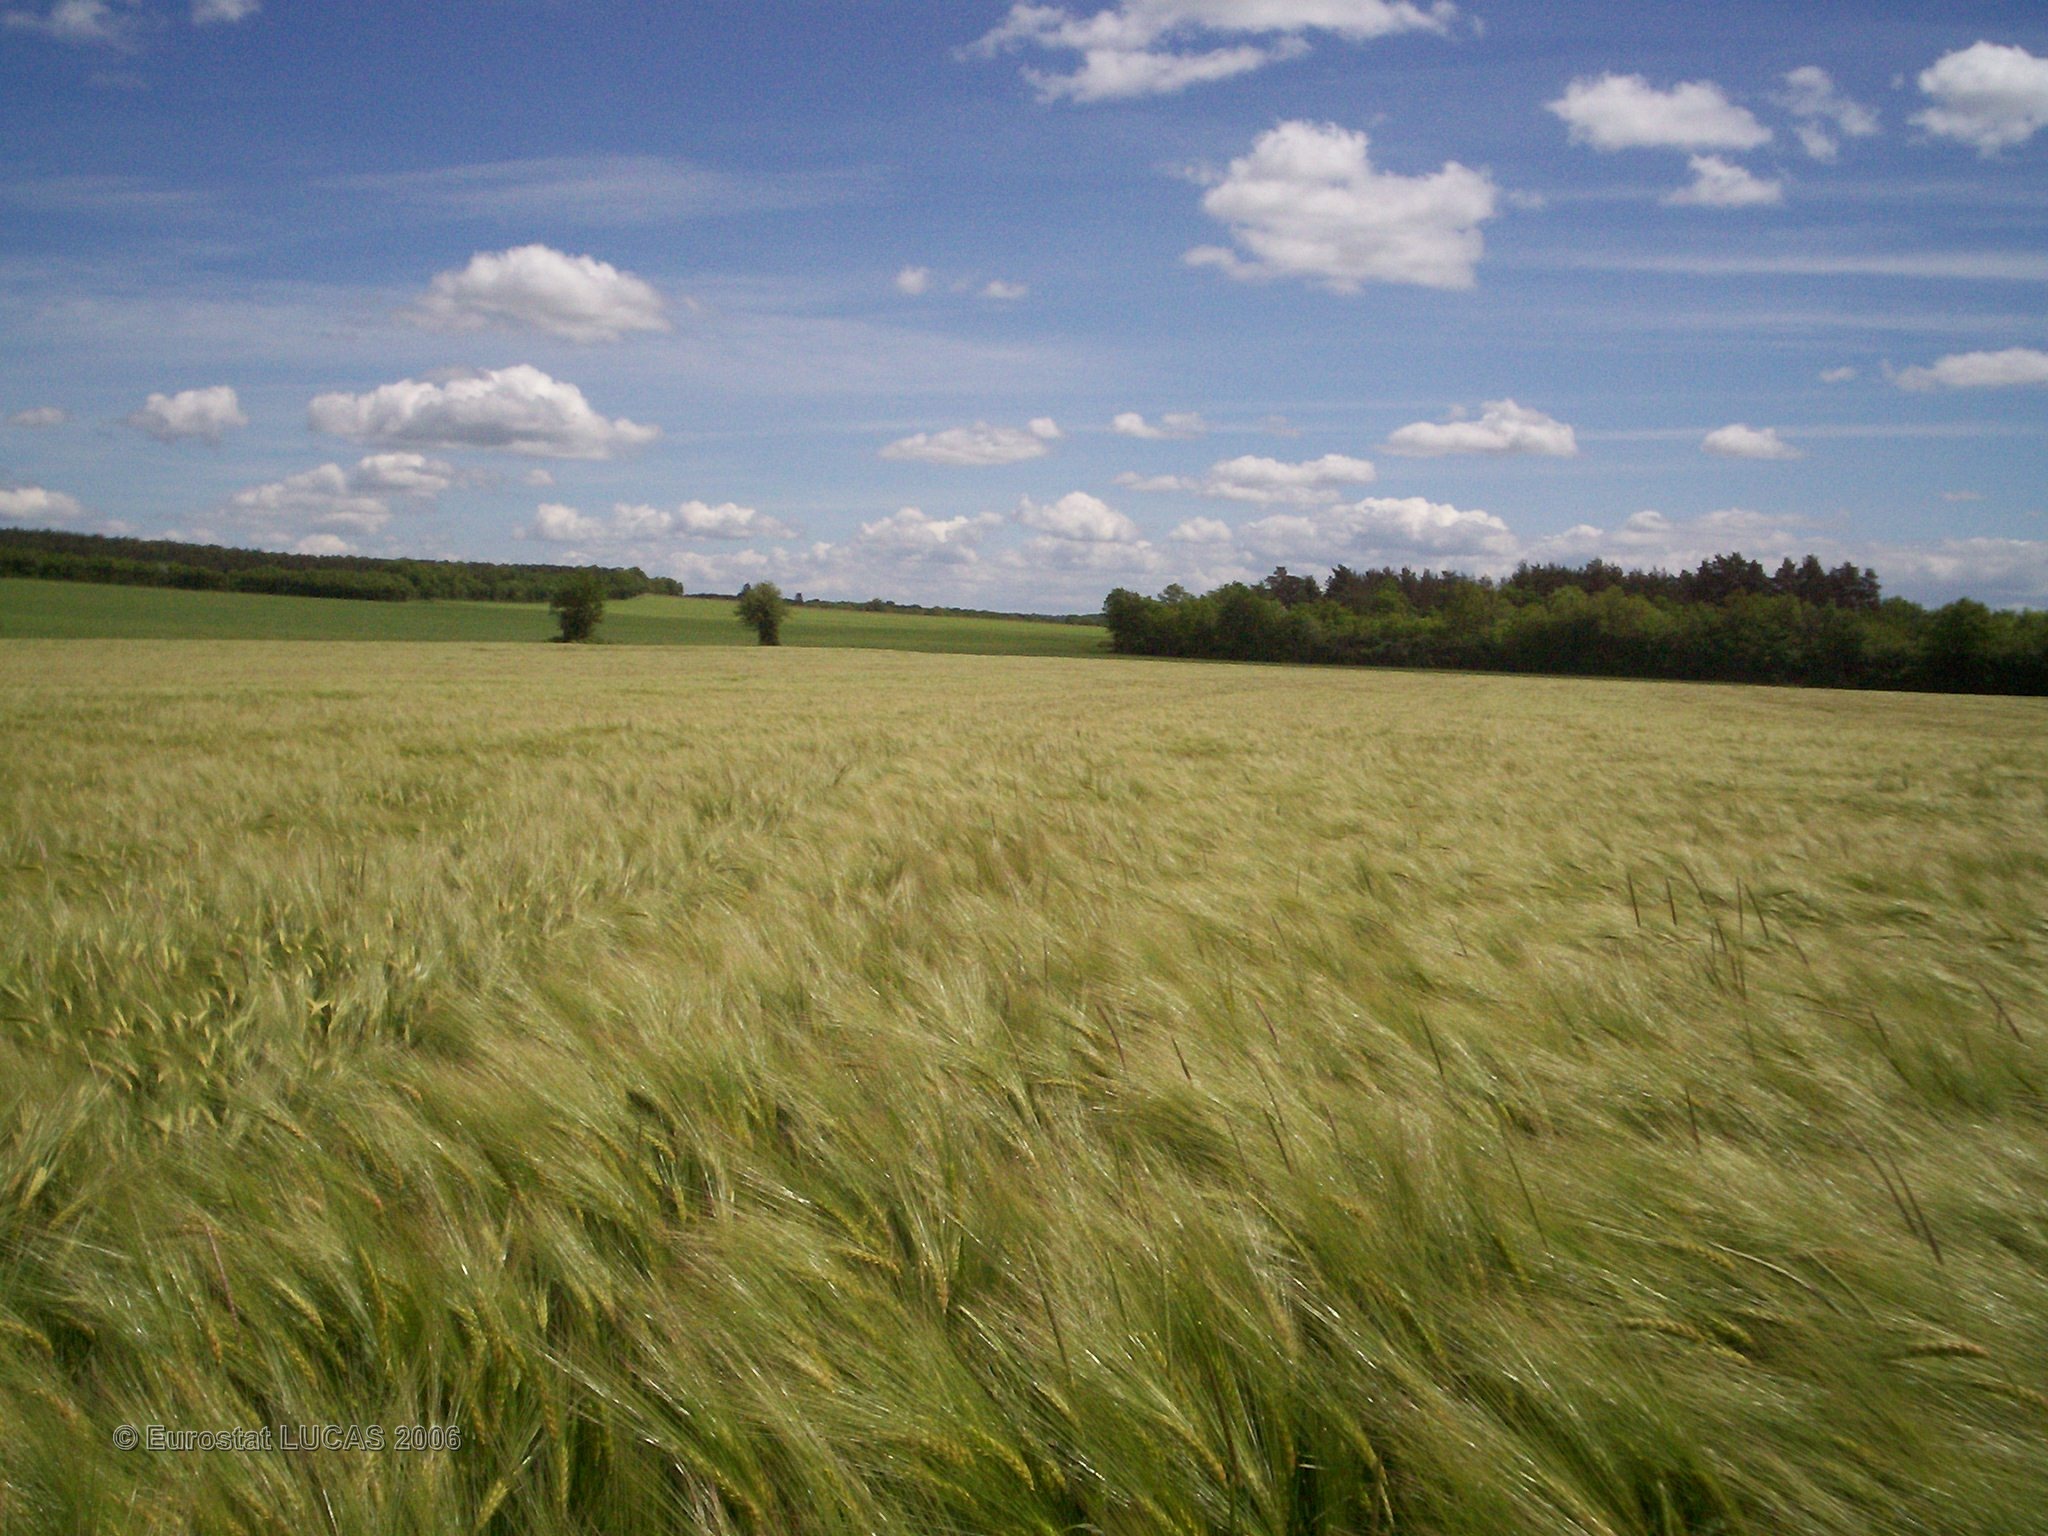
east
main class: Cropland
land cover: Barley
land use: Agriculture (excluding fallow land and kitchen gardens)
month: May
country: FR
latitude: 47.5953
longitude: 4.0797
